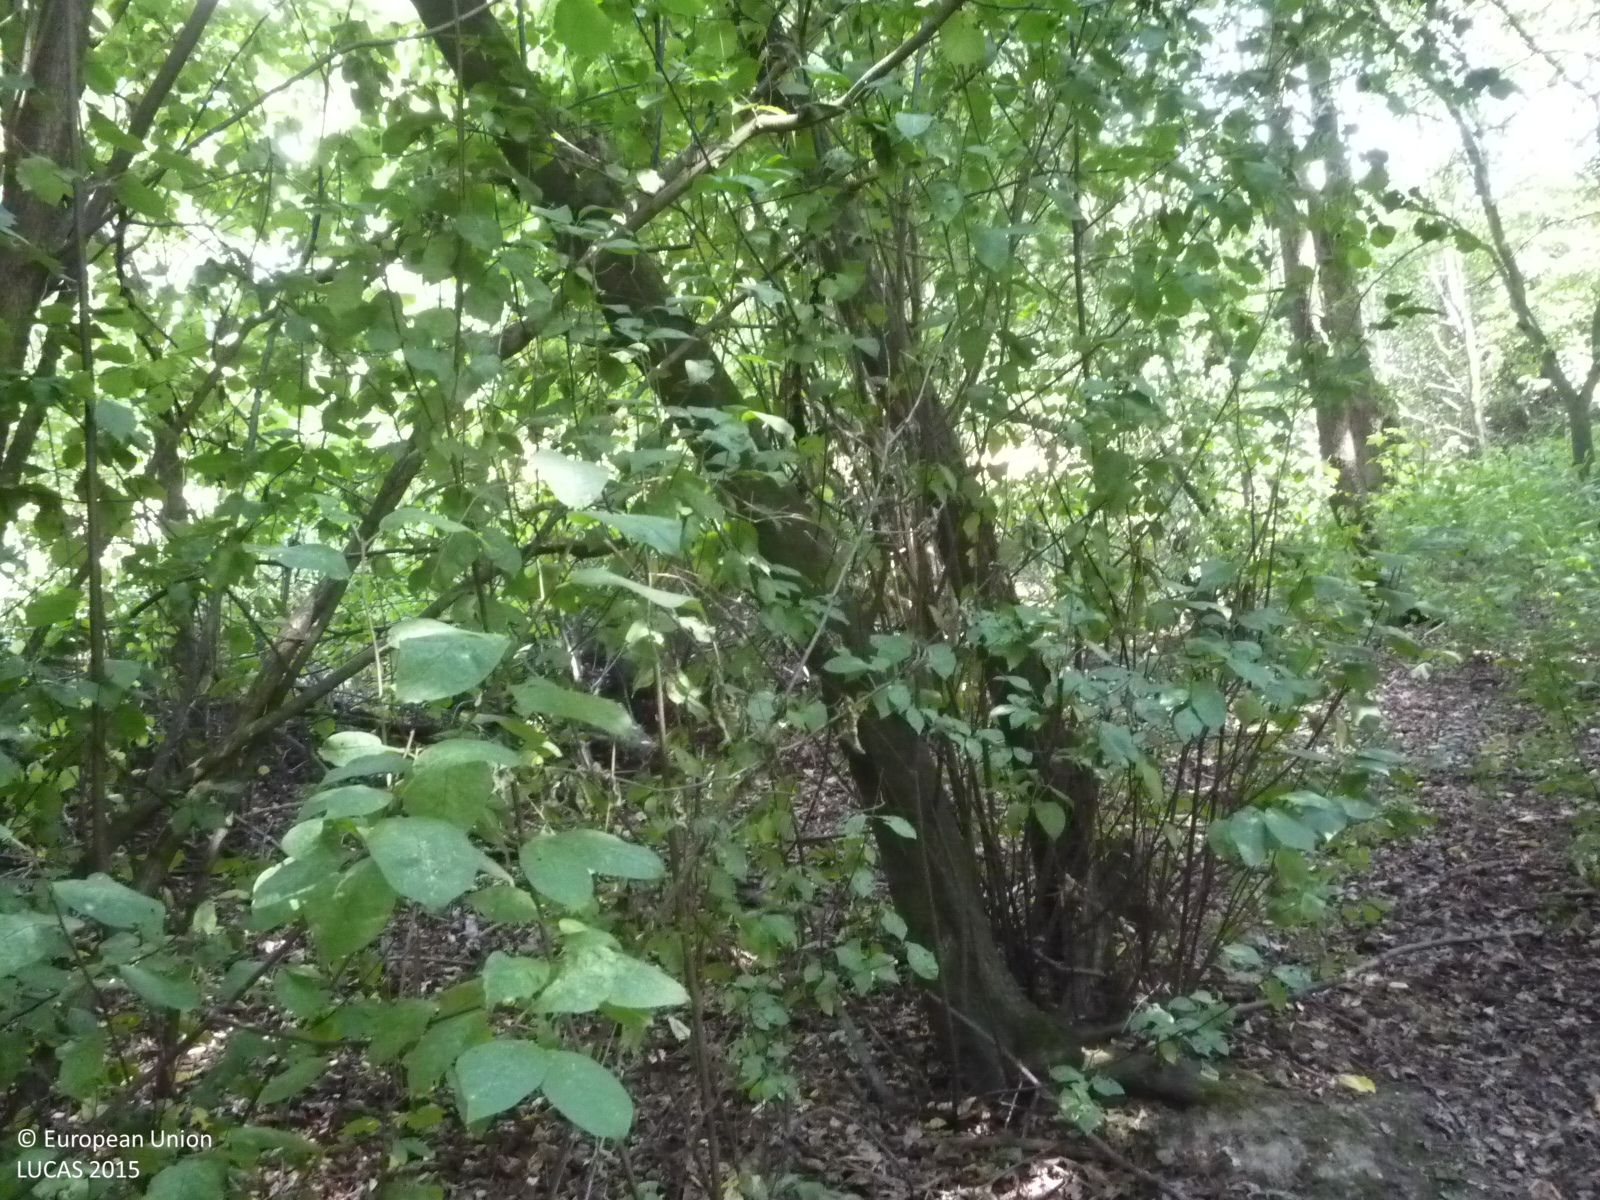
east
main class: Woodland
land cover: Broadleaved woodland
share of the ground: > 75 %
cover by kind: broadleaved forest trees 70 %, shrubs 25 %, unconsolidated bare surface 5 %
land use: Forestry
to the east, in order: Broadleaved woodland; Grassland without tree/shrub cover; Broadleaved woodland; Grassland without tree/shrub cover; Broadleaved woodland; Common wheat
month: August
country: CZ
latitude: 49.8956
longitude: 14.9724
